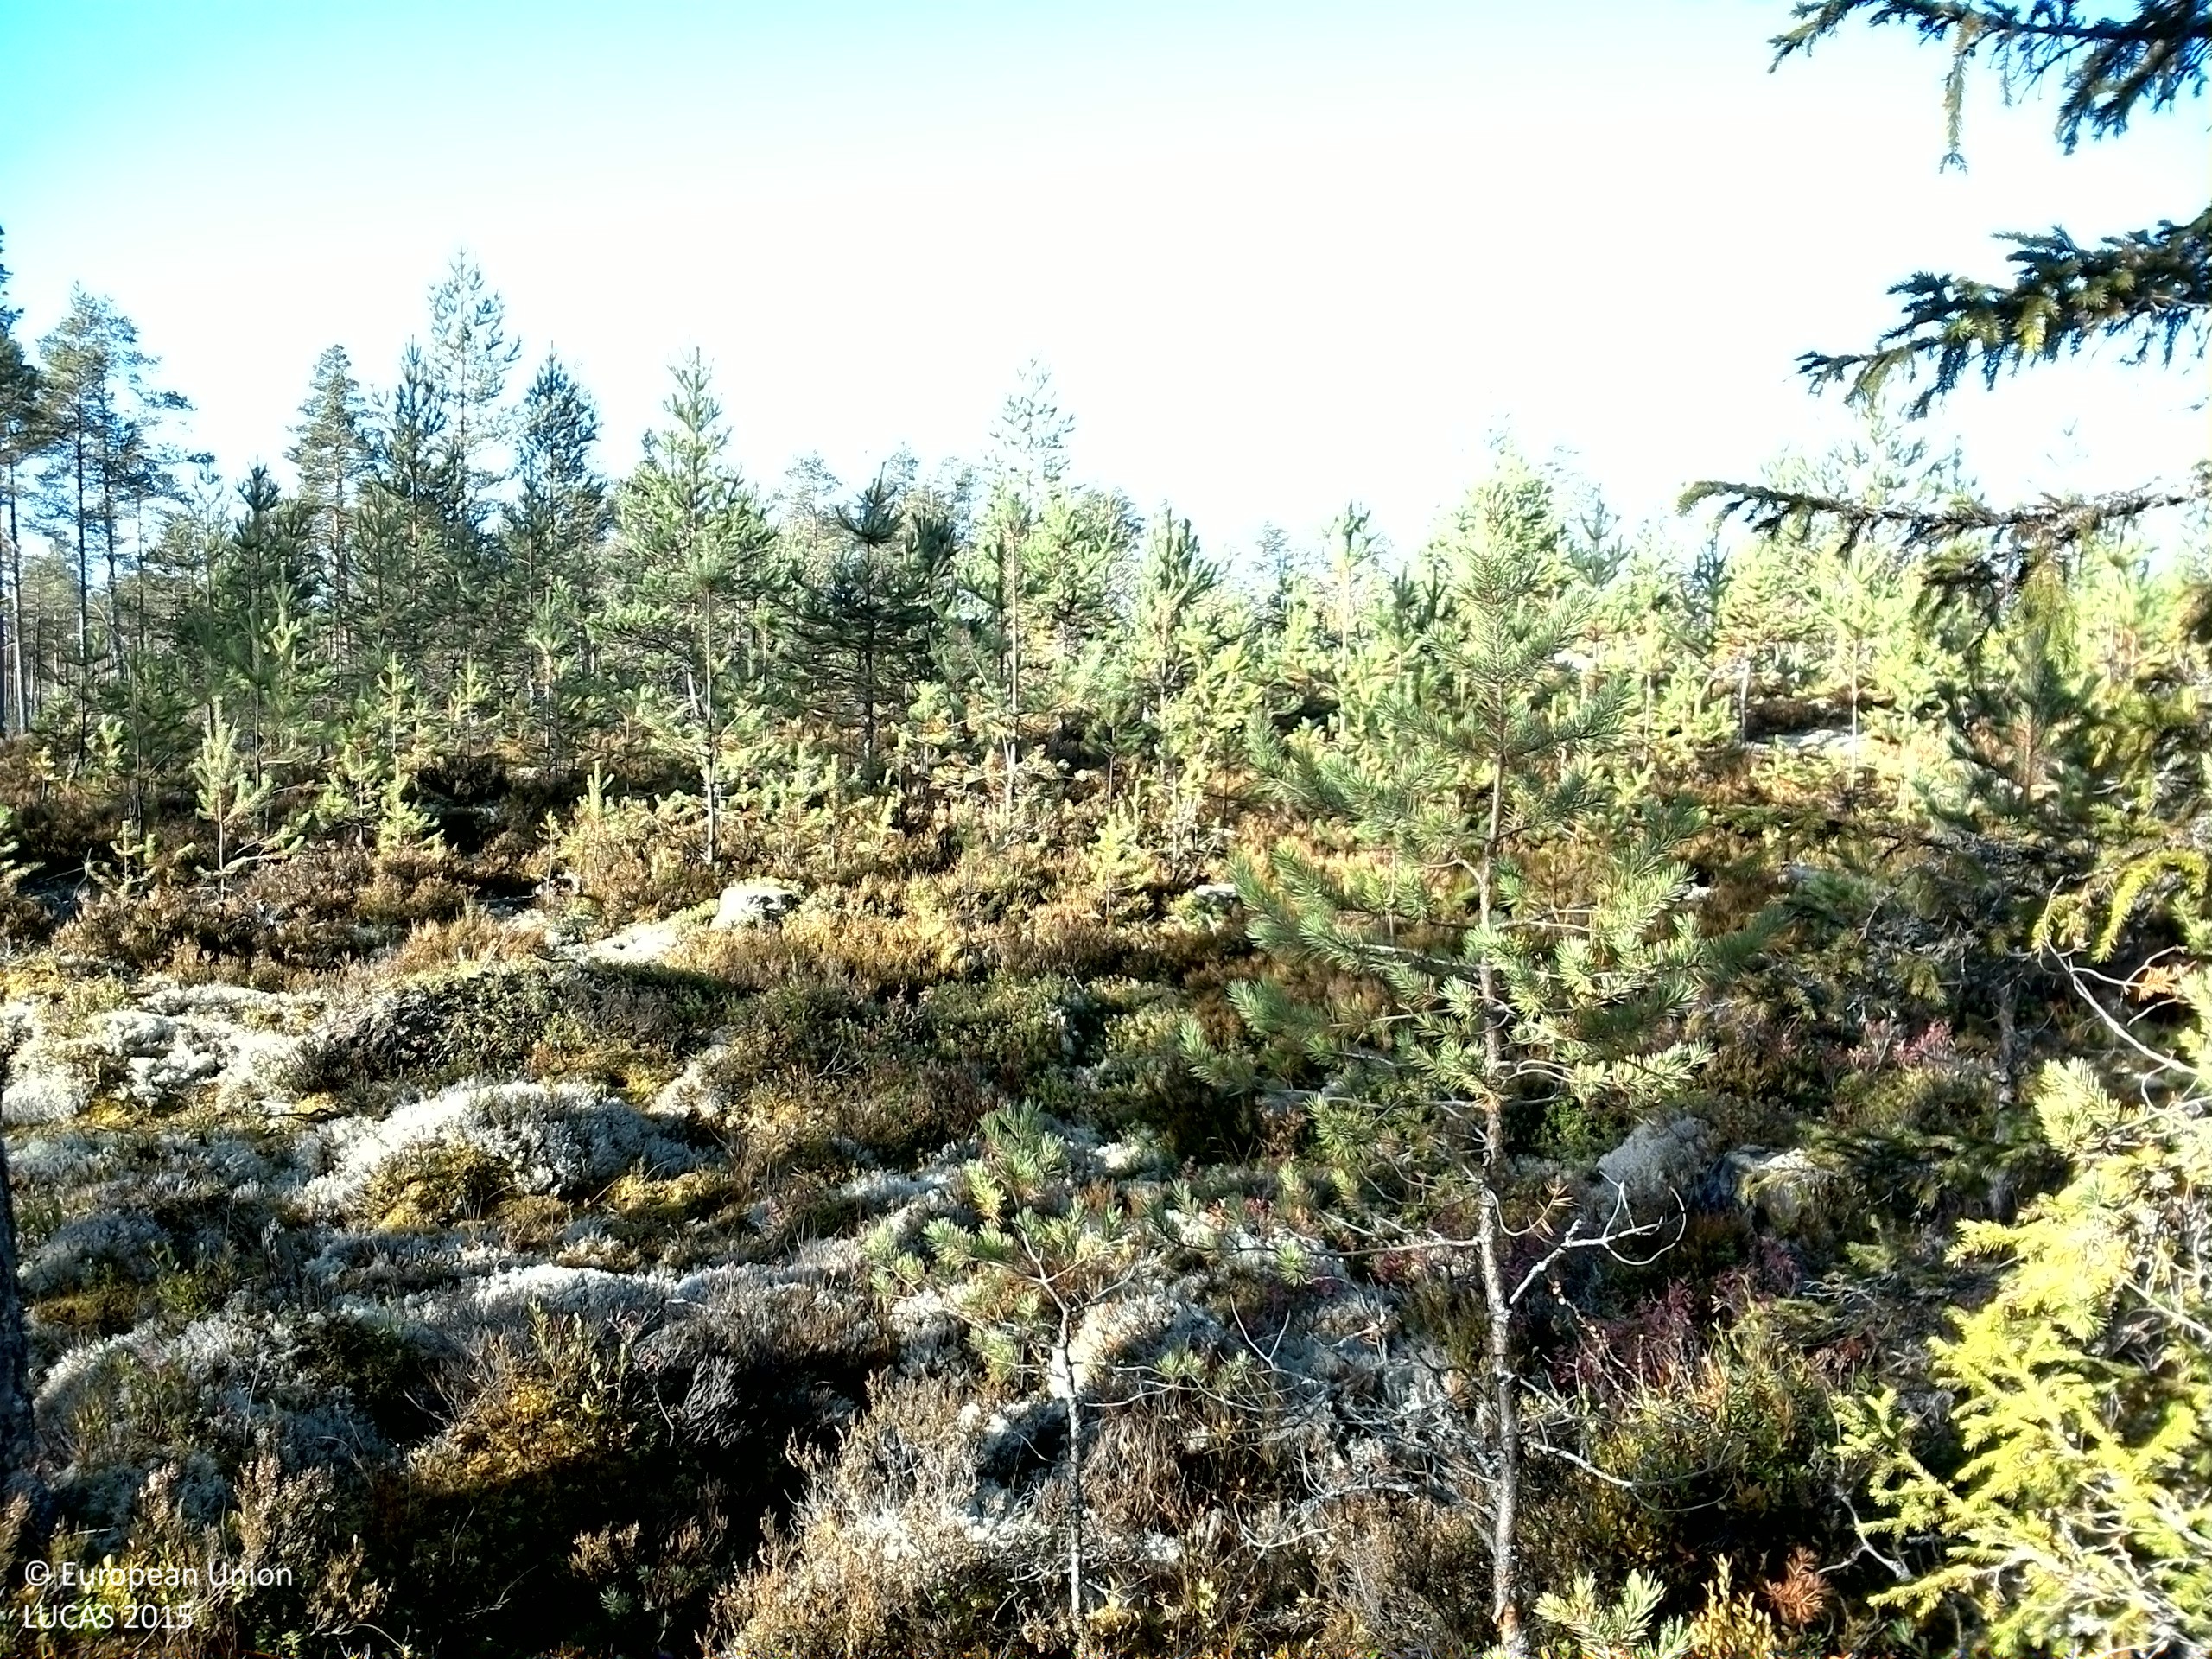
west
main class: Woodland
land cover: Pine dominated coniferous woodland
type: boreal forest
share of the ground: 50 - 75 %
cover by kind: coniferous forest trees 50 %, shrubs 30 %, lichens and mosses 15 %, herbaceous plants 5 %
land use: Forestry
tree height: > 5 m
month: October
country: SE
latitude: 61.1828
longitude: 15.2856
